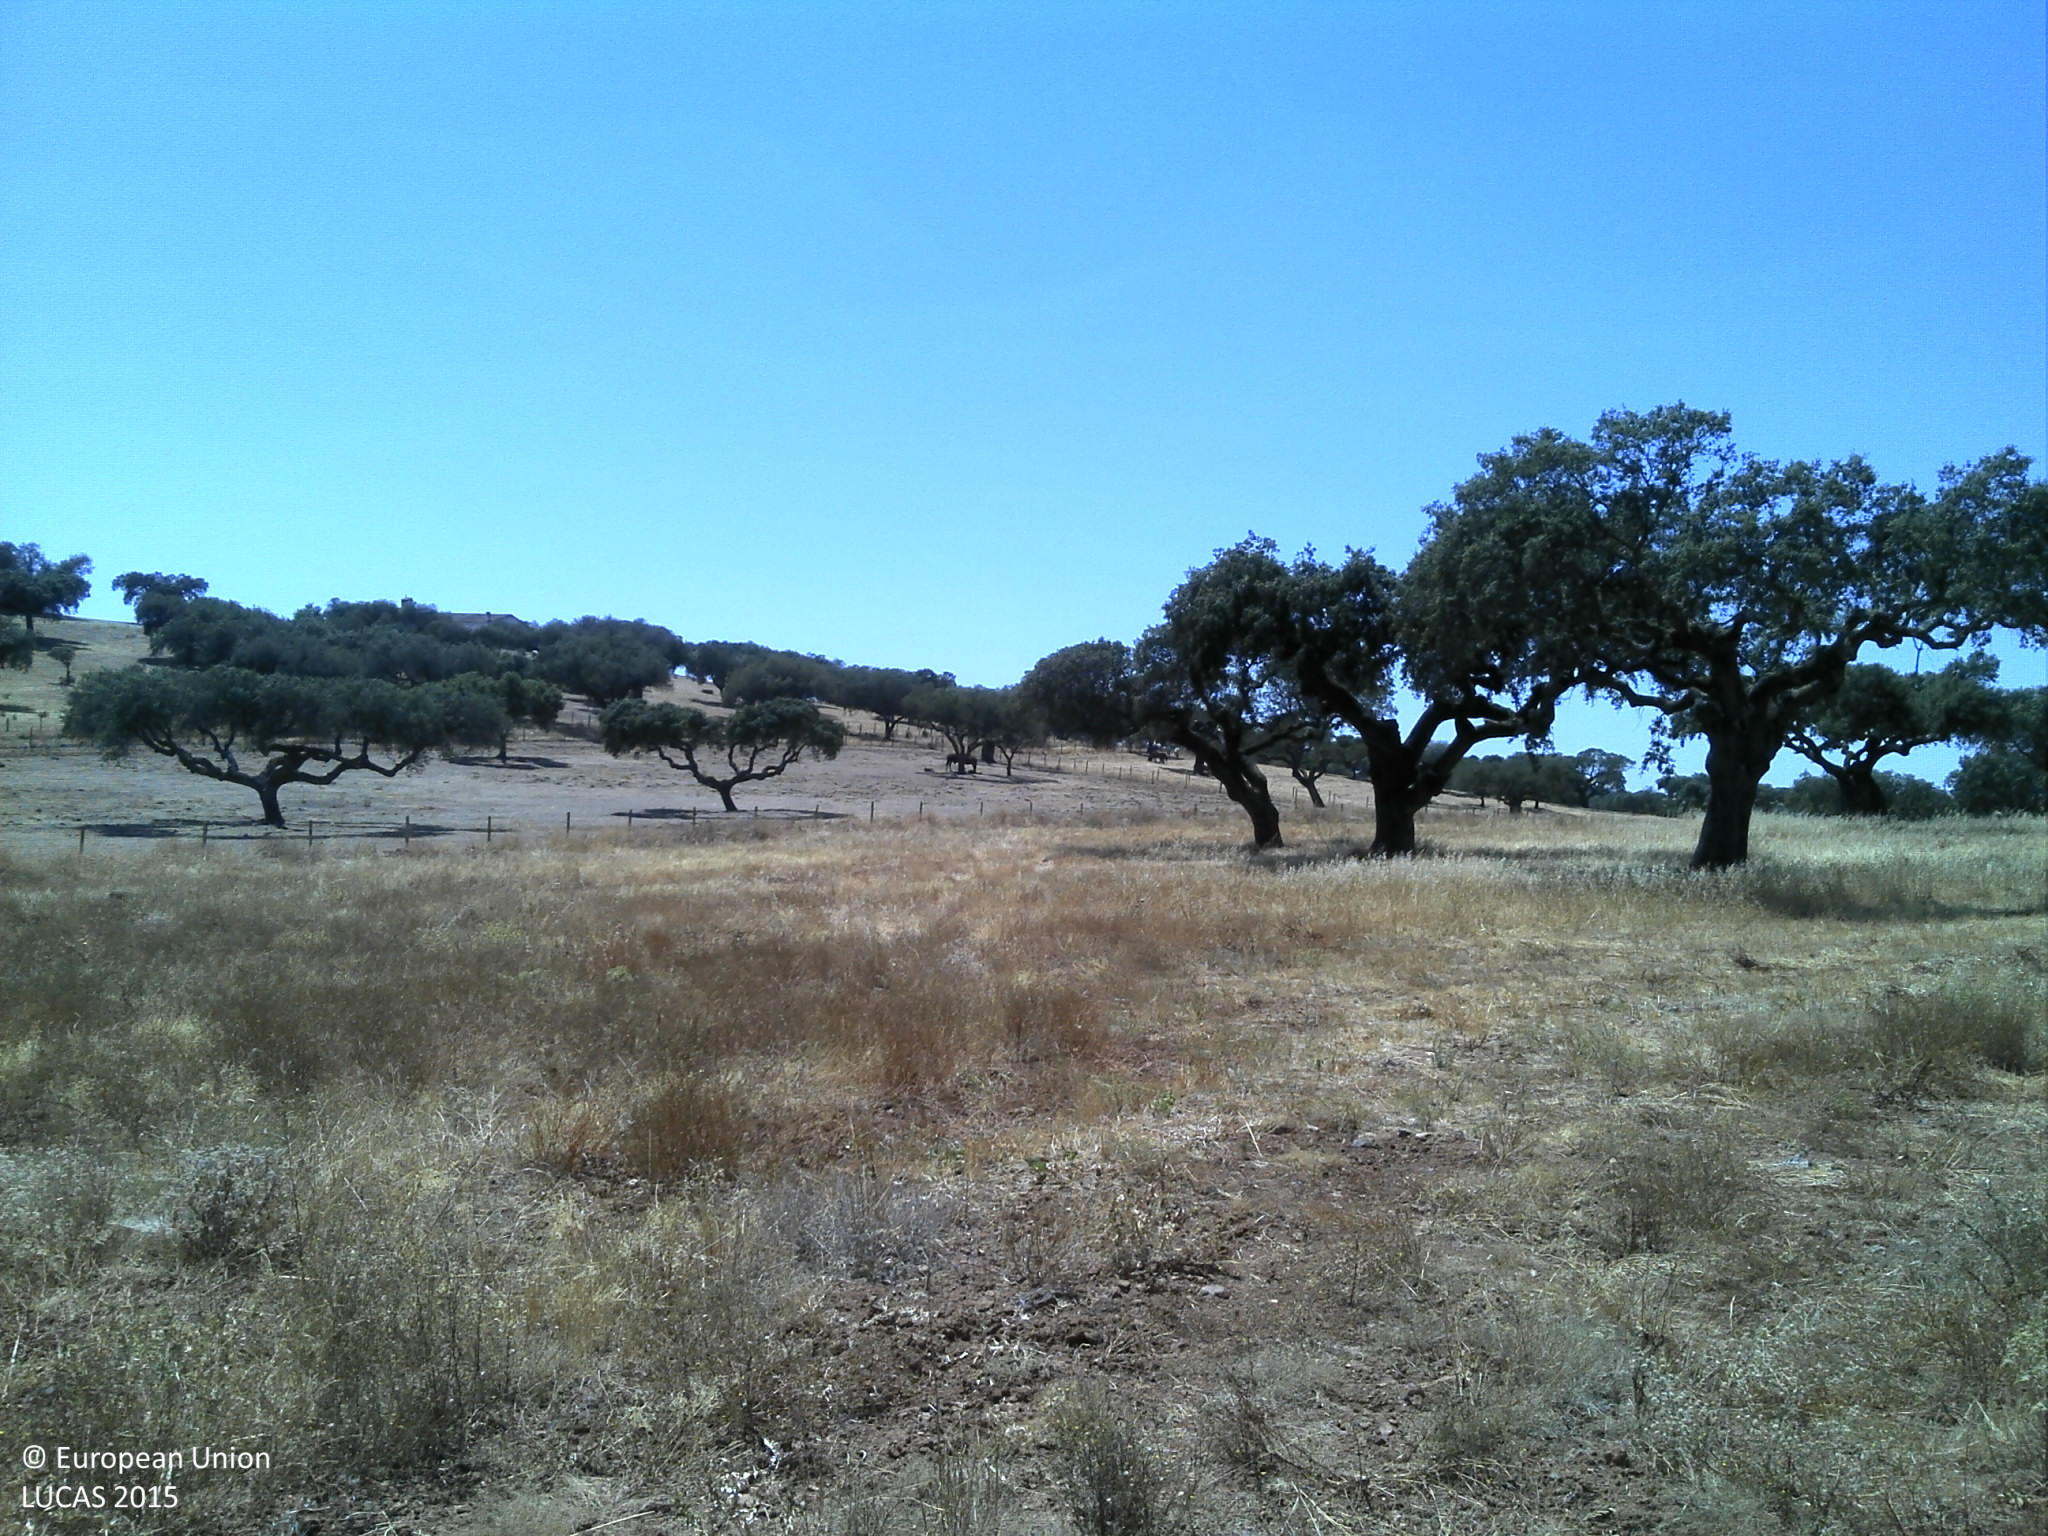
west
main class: Grassland
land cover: Grassland without tree/shrub cover
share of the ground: 25 - 50 %
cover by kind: unconsolidated bare surface 60 %, herbaceous plants 40 %
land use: Agriculture (excluding fallow land and kitchen gardens)
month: July
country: PT
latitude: 38.5480
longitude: -7.3167
